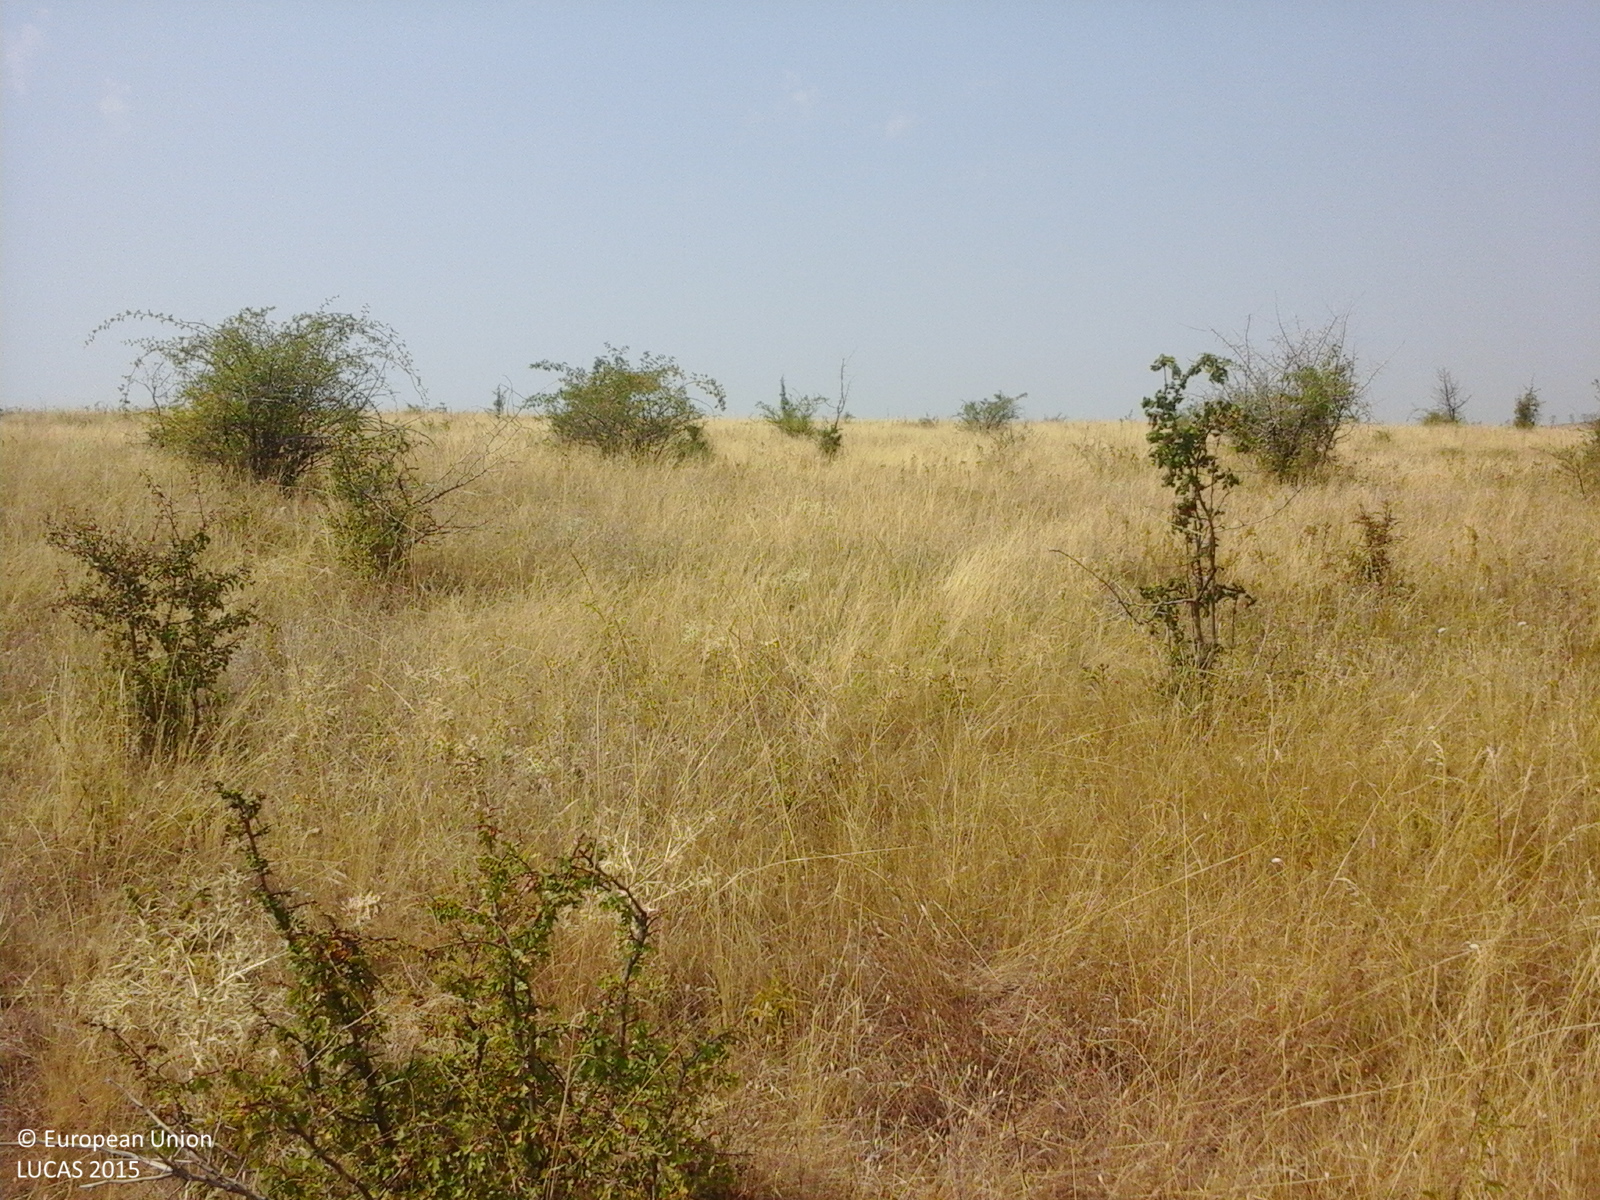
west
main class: Grassland
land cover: Grassland with sparse tree/shrub cover
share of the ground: > 75 %
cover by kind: herbaceous plants 95 %, broadleaved forest trees 5 %
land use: Agriculture (excluding fallow land and kitchen gardens)
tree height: > 5 m
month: August
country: RO
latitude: 44.3617
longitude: 23.3372
